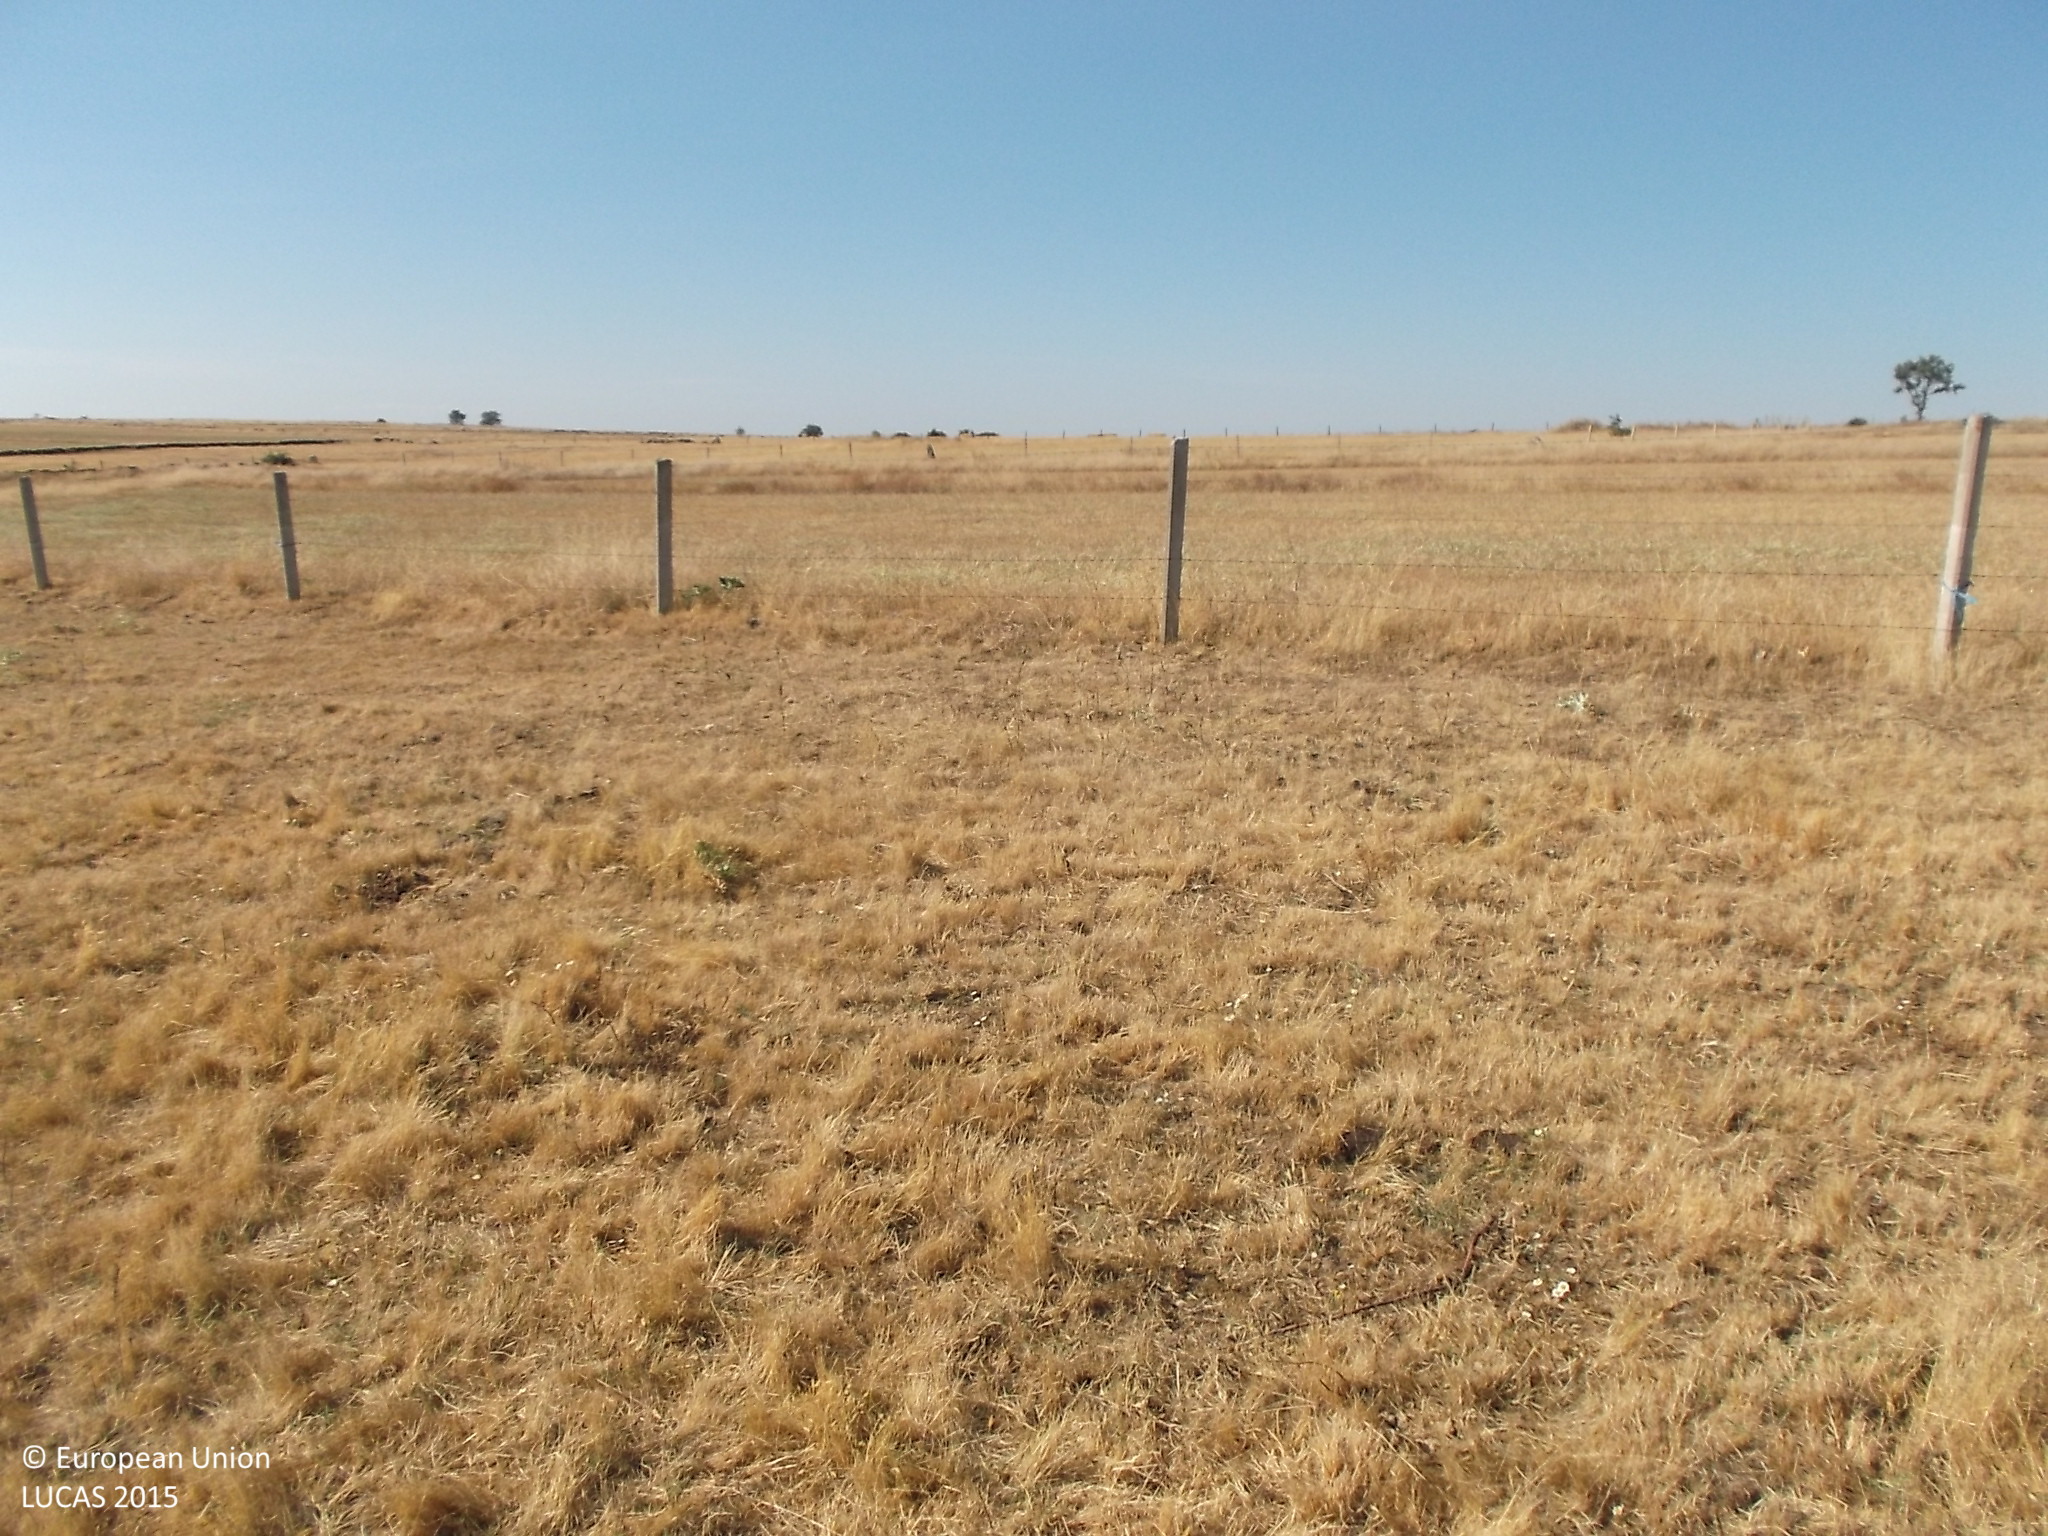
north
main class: Grassland
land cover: Grassland without tree/shrub cover
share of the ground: > 75 %
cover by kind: herbaceous plants 100 %
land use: Agriculture (excluding fallow land and kitchen gardens)
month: July
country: ES
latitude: 41.3014
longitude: -5.9848
